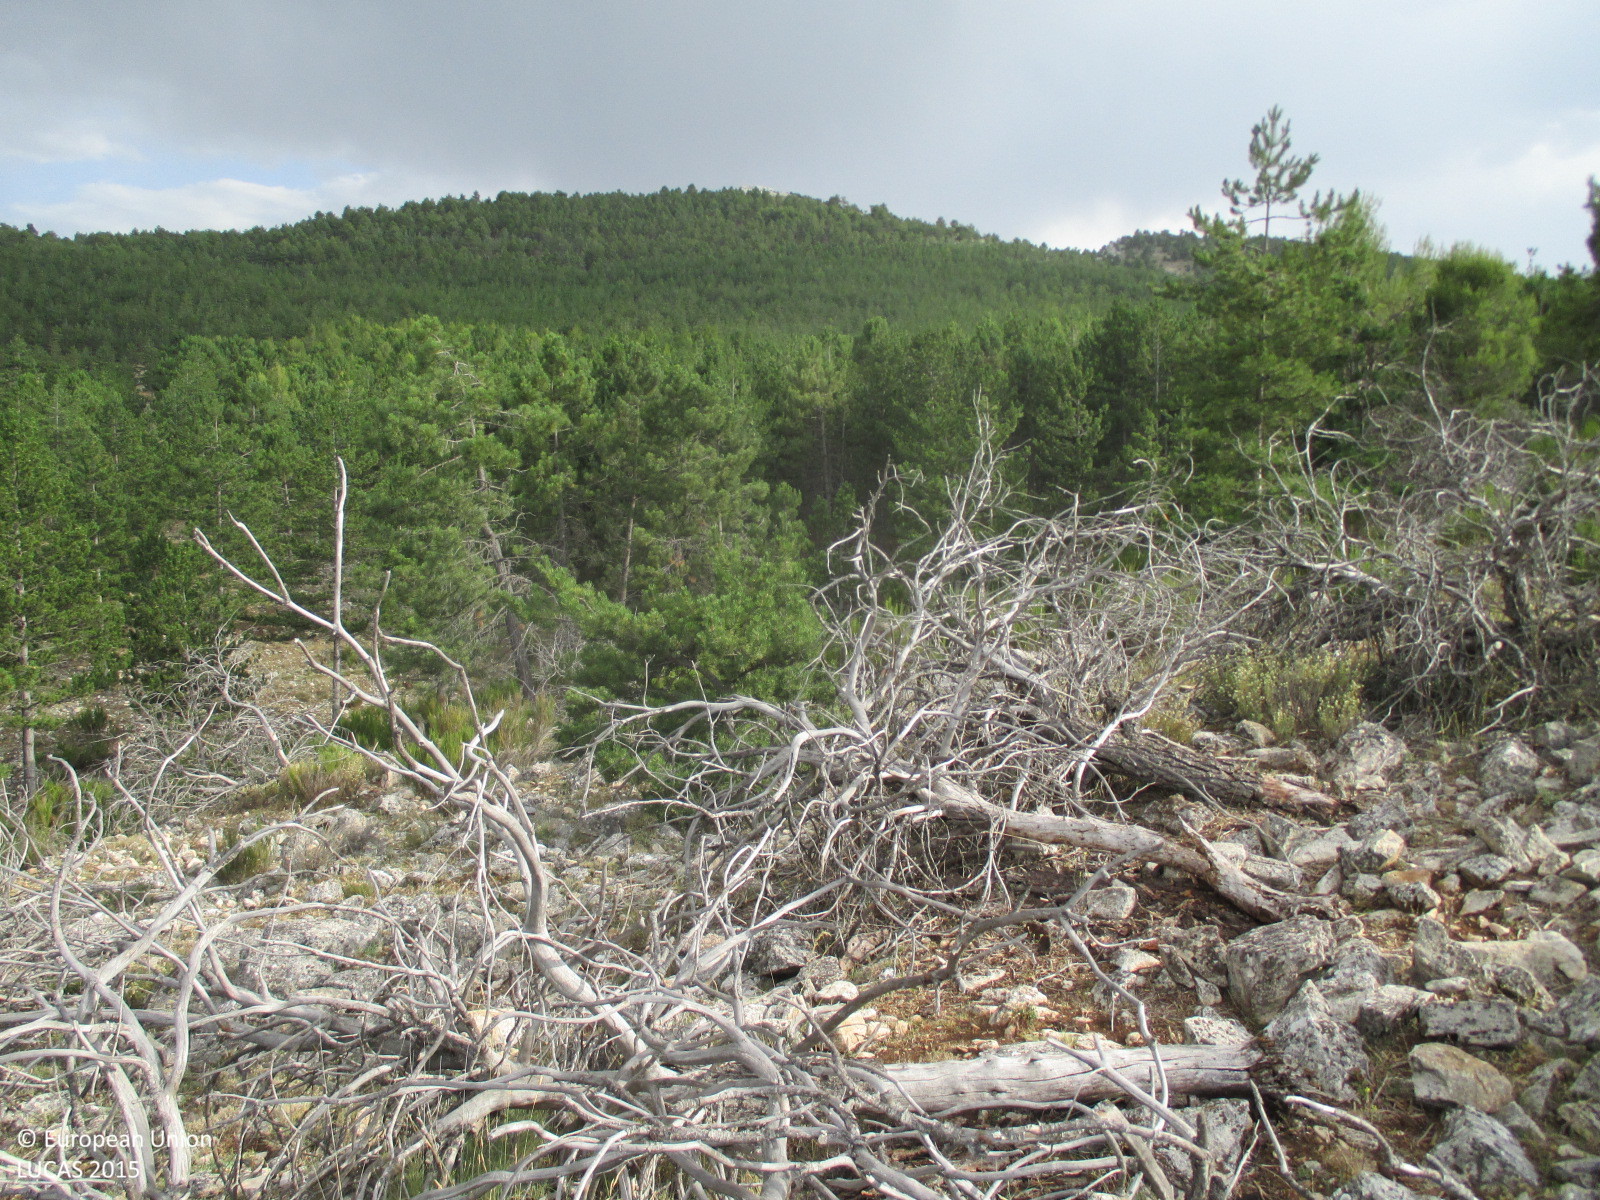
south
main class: Shrubland
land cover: Shrubland with sparse tree cover
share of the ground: 50 - 75 %
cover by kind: shrubs 60 %, herbaceous plants 35 %, coniferous forest trees 5 %
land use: Semi-natural and natural areas not in use
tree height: < 5 m
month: July
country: ES
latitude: 38.1571
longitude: -2.4219
